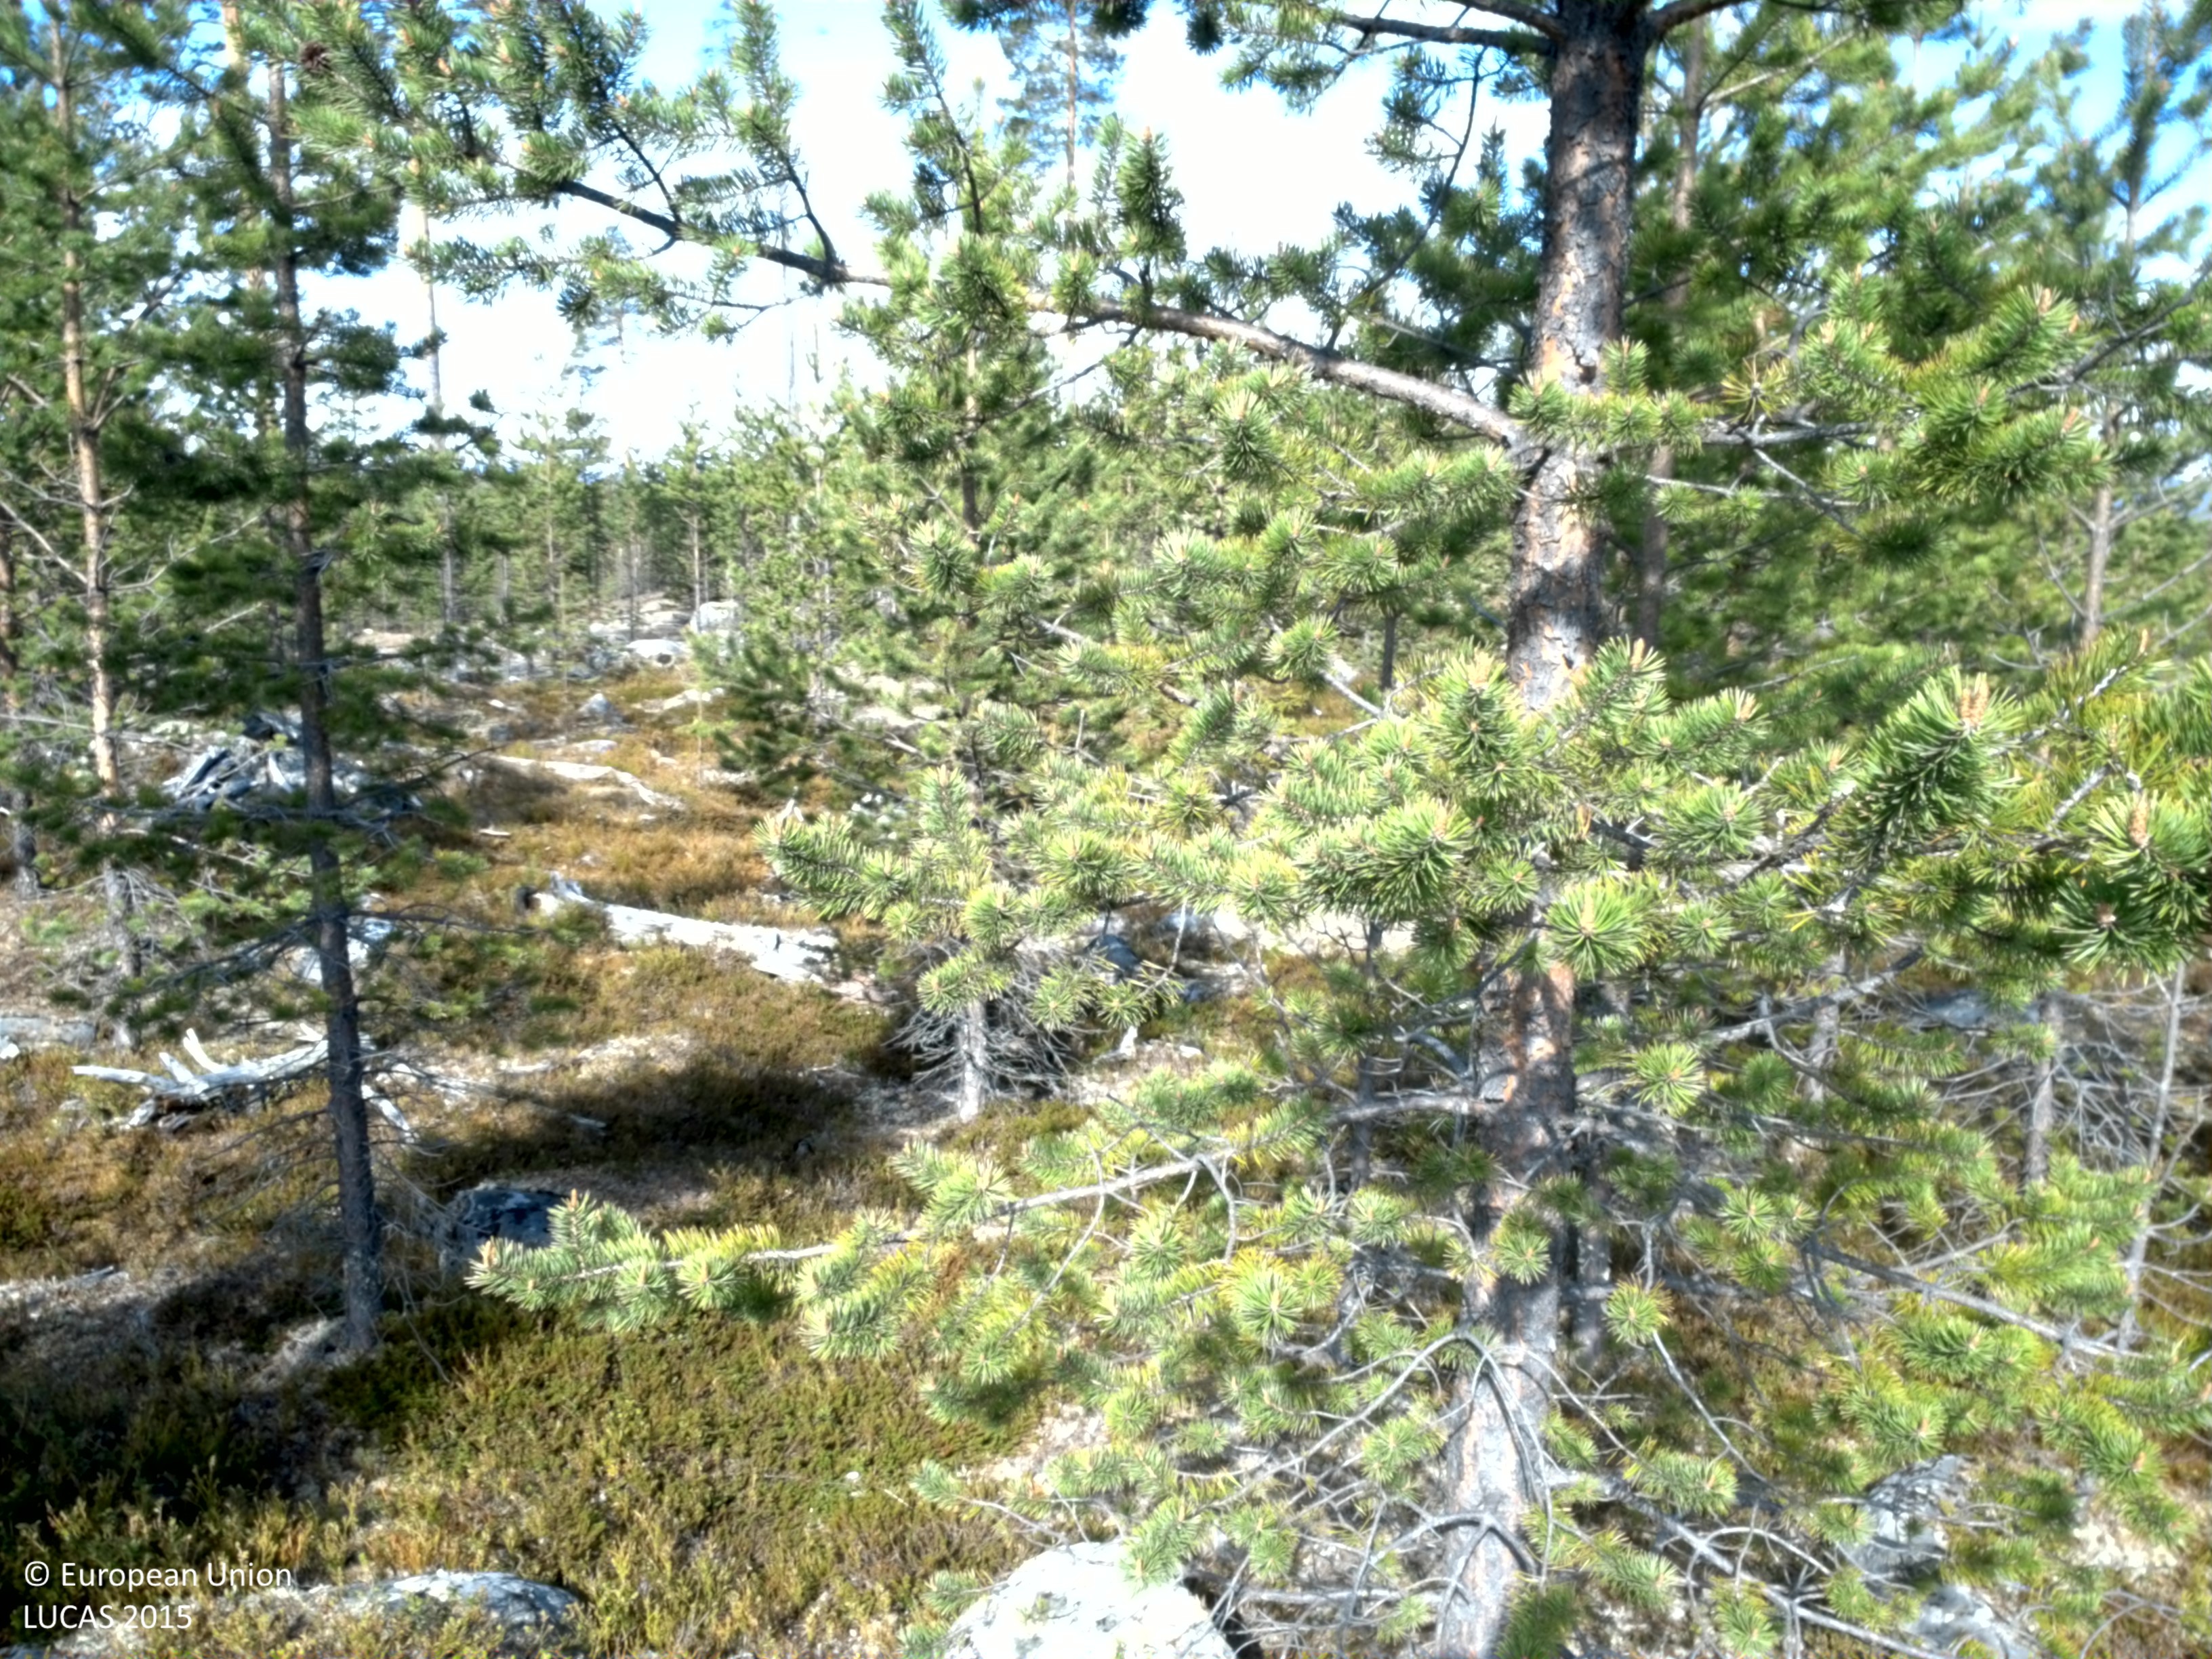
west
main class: Woodland
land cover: Pine dominated coniferous woodland
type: boreal forest
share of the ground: 10 - 25 %
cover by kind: shrubs 55 %, coniferous forest trees 20 %, consolidated bare surface 15 %, lichens and mosses 10 %
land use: Forestry
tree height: < 5 m
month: June
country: SE
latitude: 65.9413
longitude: 18.7276
